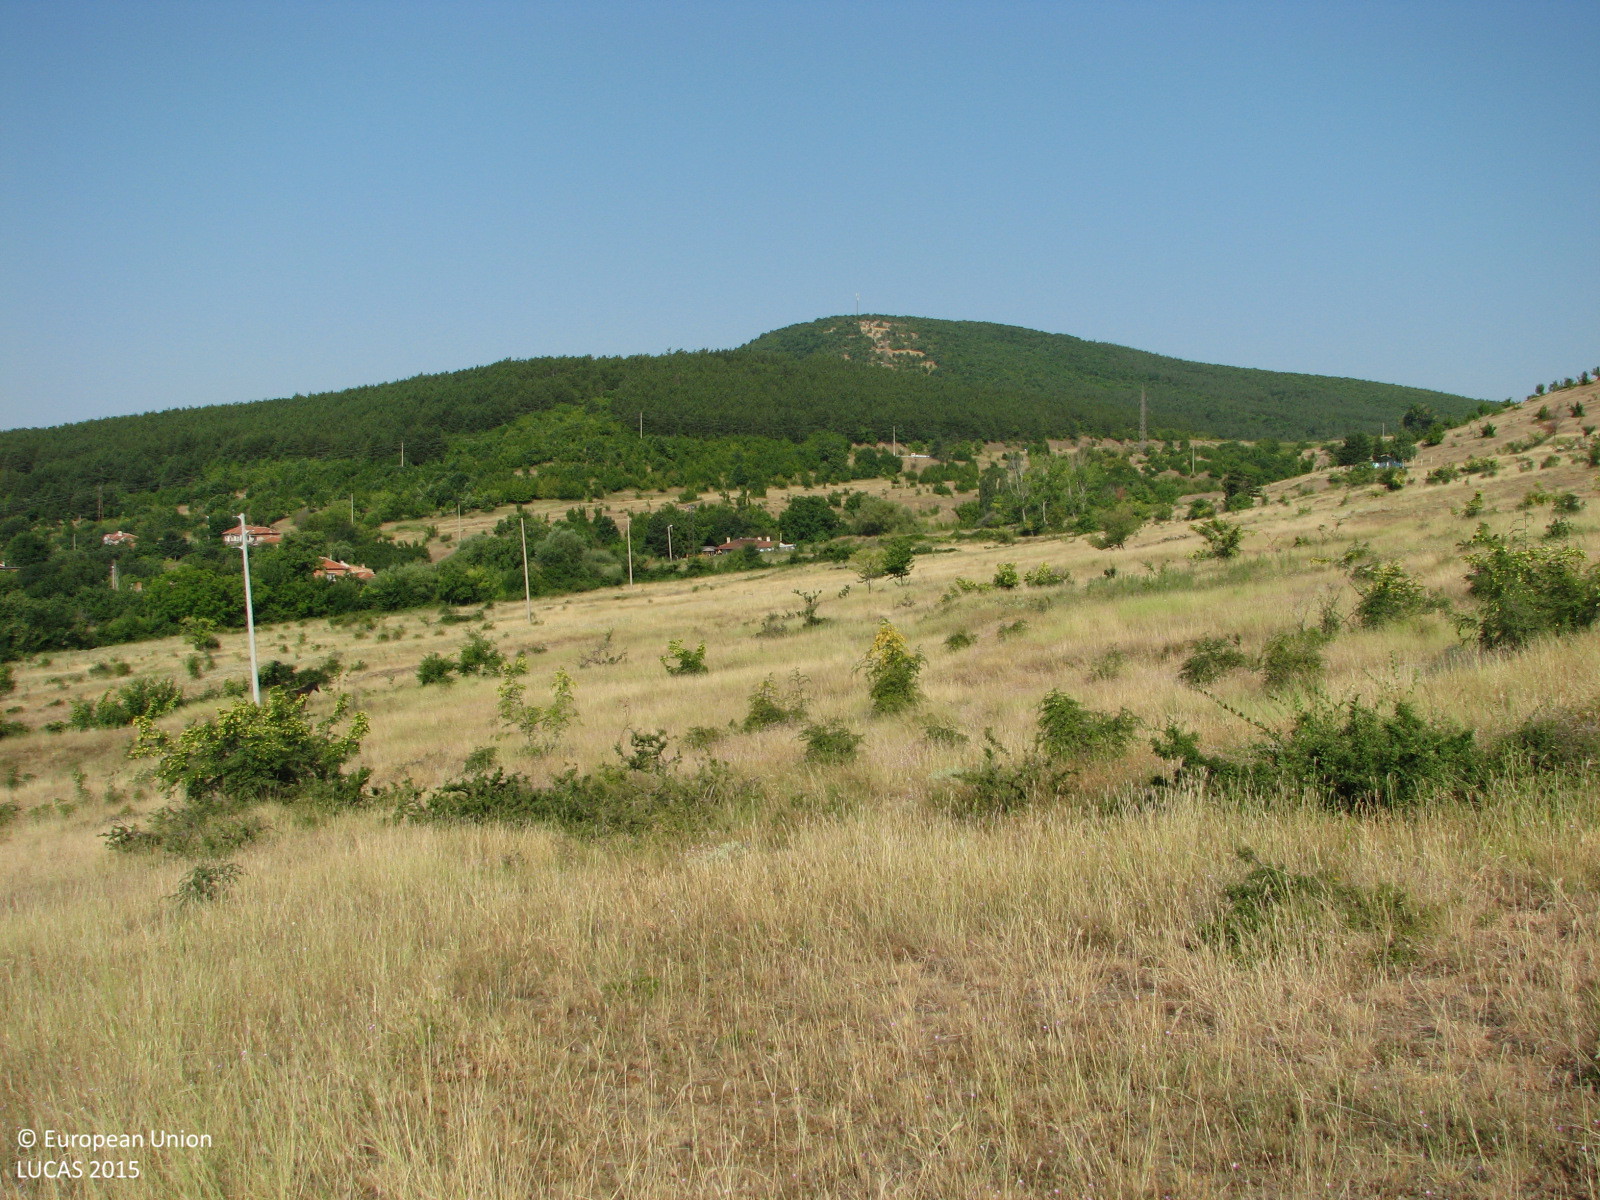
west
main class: Grassland
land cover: Grassland with sparse tree/shrub cover
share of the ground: > 75 %
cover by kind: herbaceous plants 90 %, broadleaved forest trees 5 %, shrubs 5 %
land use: Agriculture (excluding fallow land and kitchen gardens)
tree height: < 5 m
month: July
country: BG
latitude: 42.6526
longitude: 26.1512
